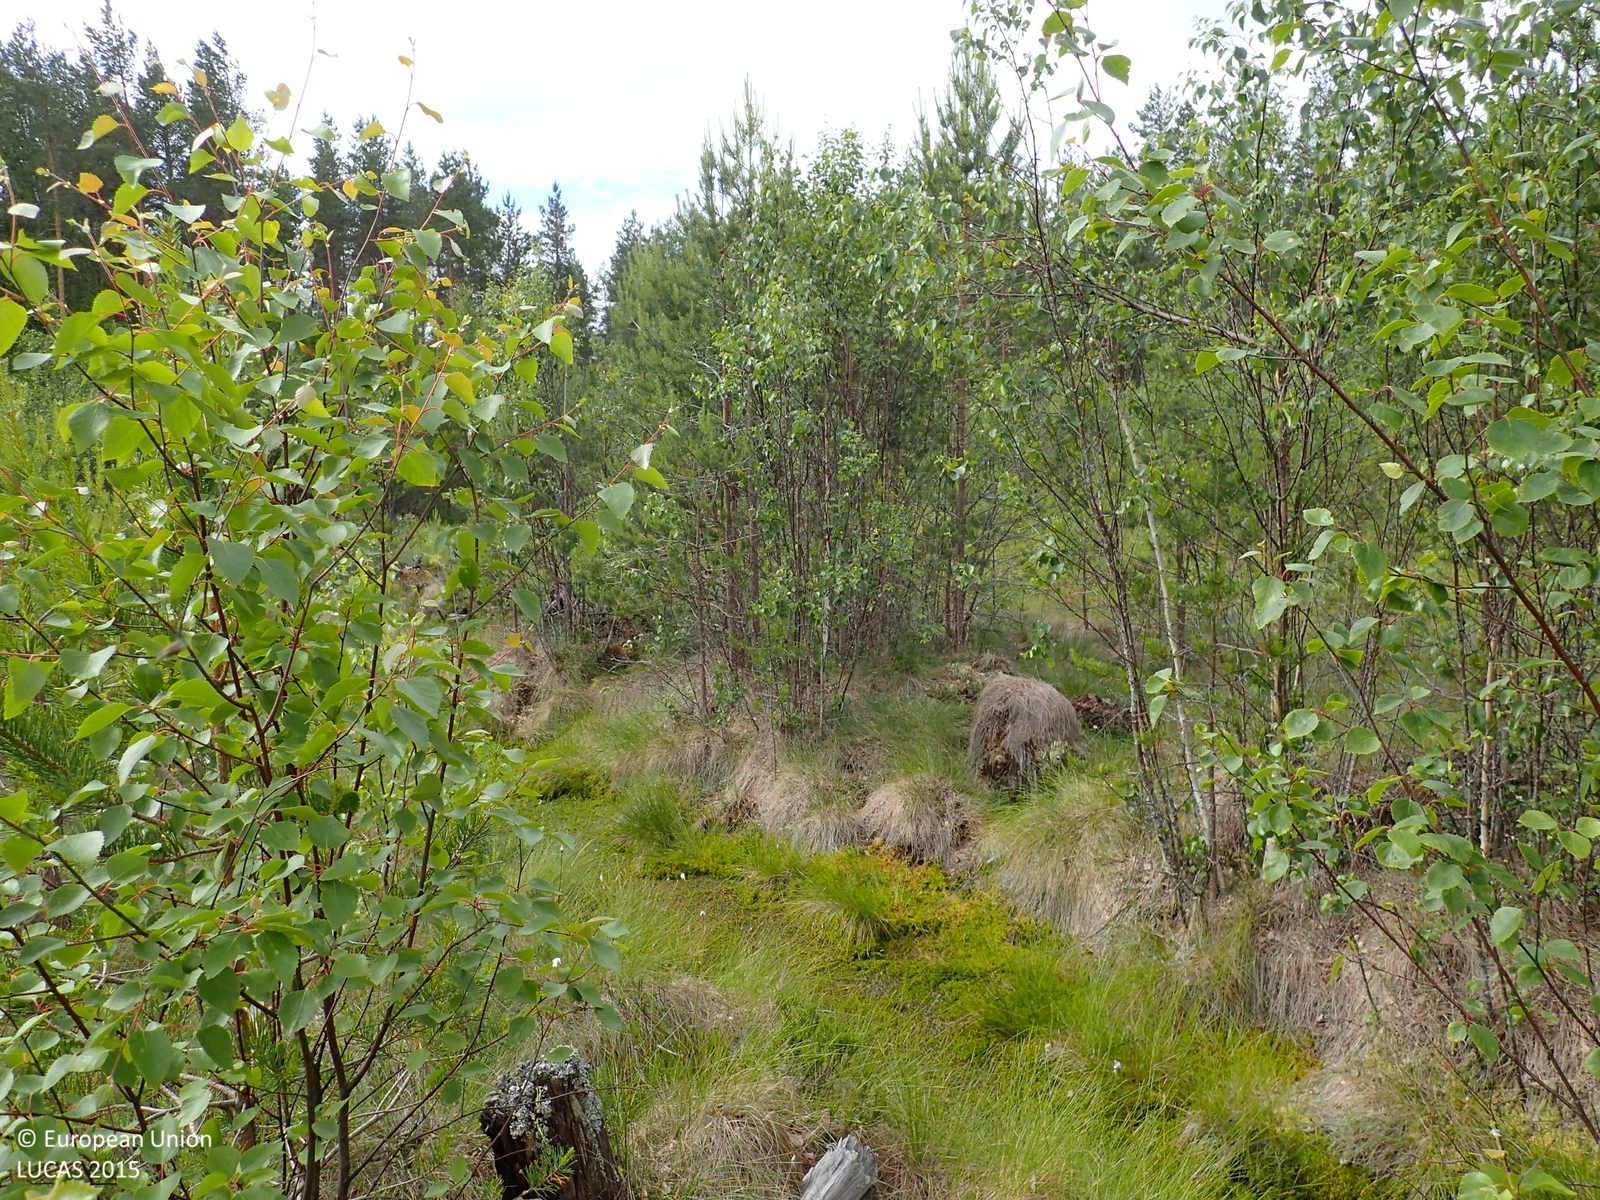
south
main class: Woodland
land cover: Pine dominated mixed woodland
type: mire and swamp forests
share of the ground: 25 - 50 %
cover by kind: herbaceous plants 50 %, unconsolidated bare surface 20 %, coniferous forest trees 15 %, broadleaved forest trees 15 %
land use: Forestry
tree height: < 5 m
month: July
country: FI
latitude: 62.6394
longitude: 21.3331
